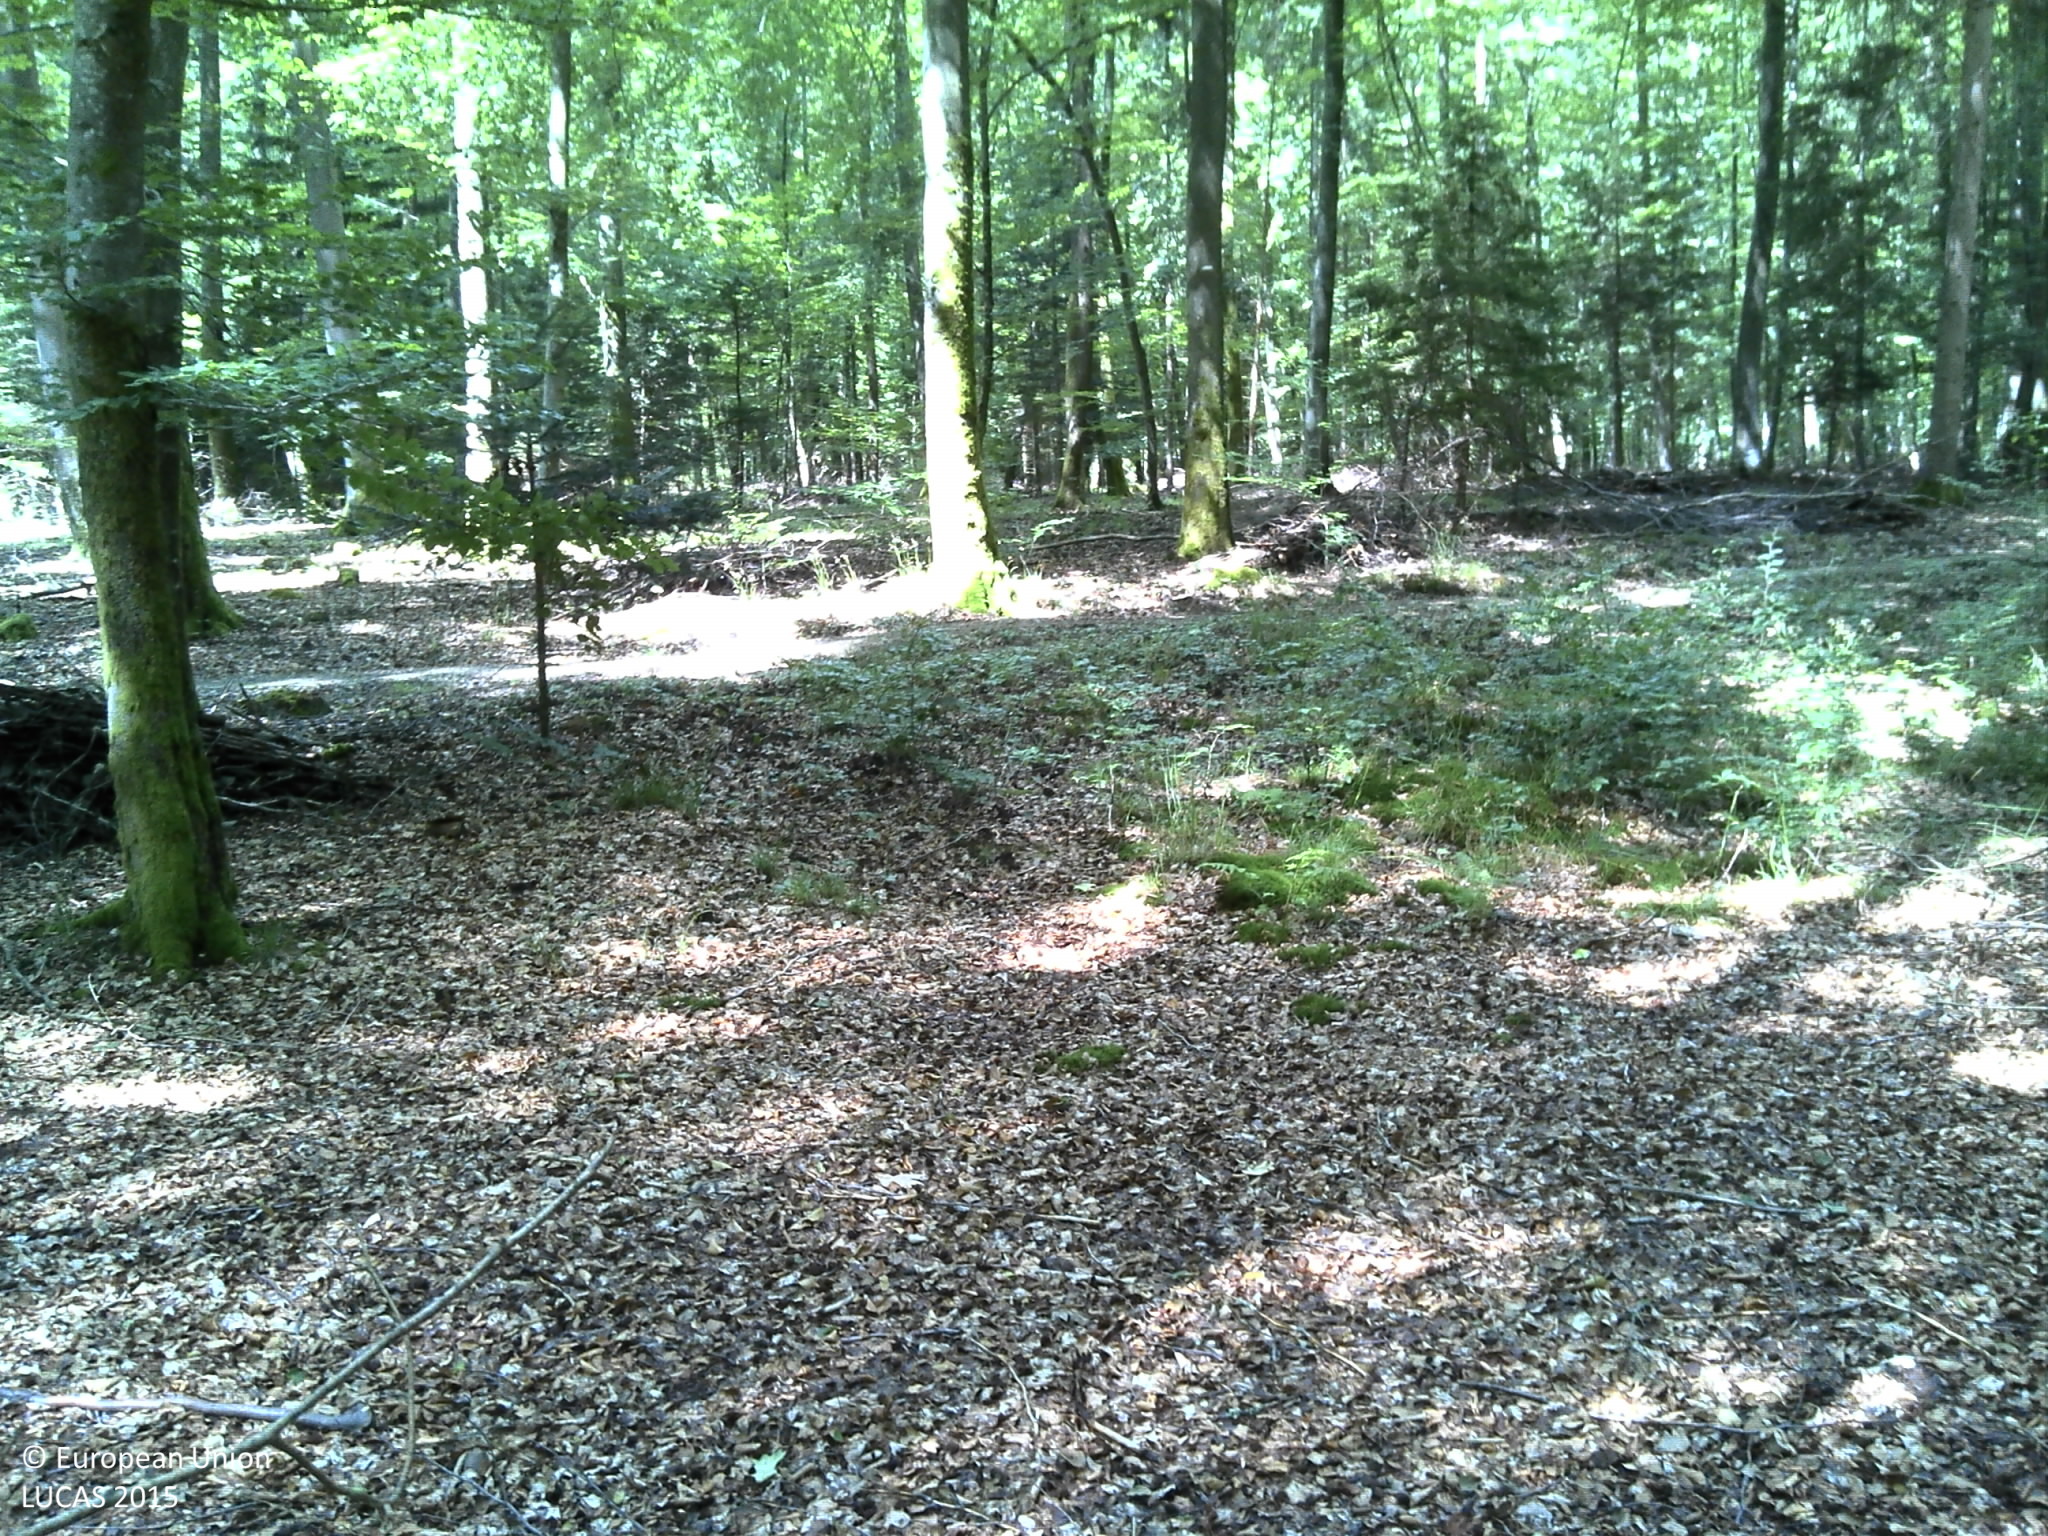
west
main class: Woodland
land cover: Broadleaved woodland
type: beech forest
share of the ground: > 75 %
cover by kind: broadleaved forest trees 90 %, unconsolidated bare surface 10 %
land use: Forestry
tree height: > 5 m
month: July
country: FR
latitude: 48.1703
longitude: 6.5719
